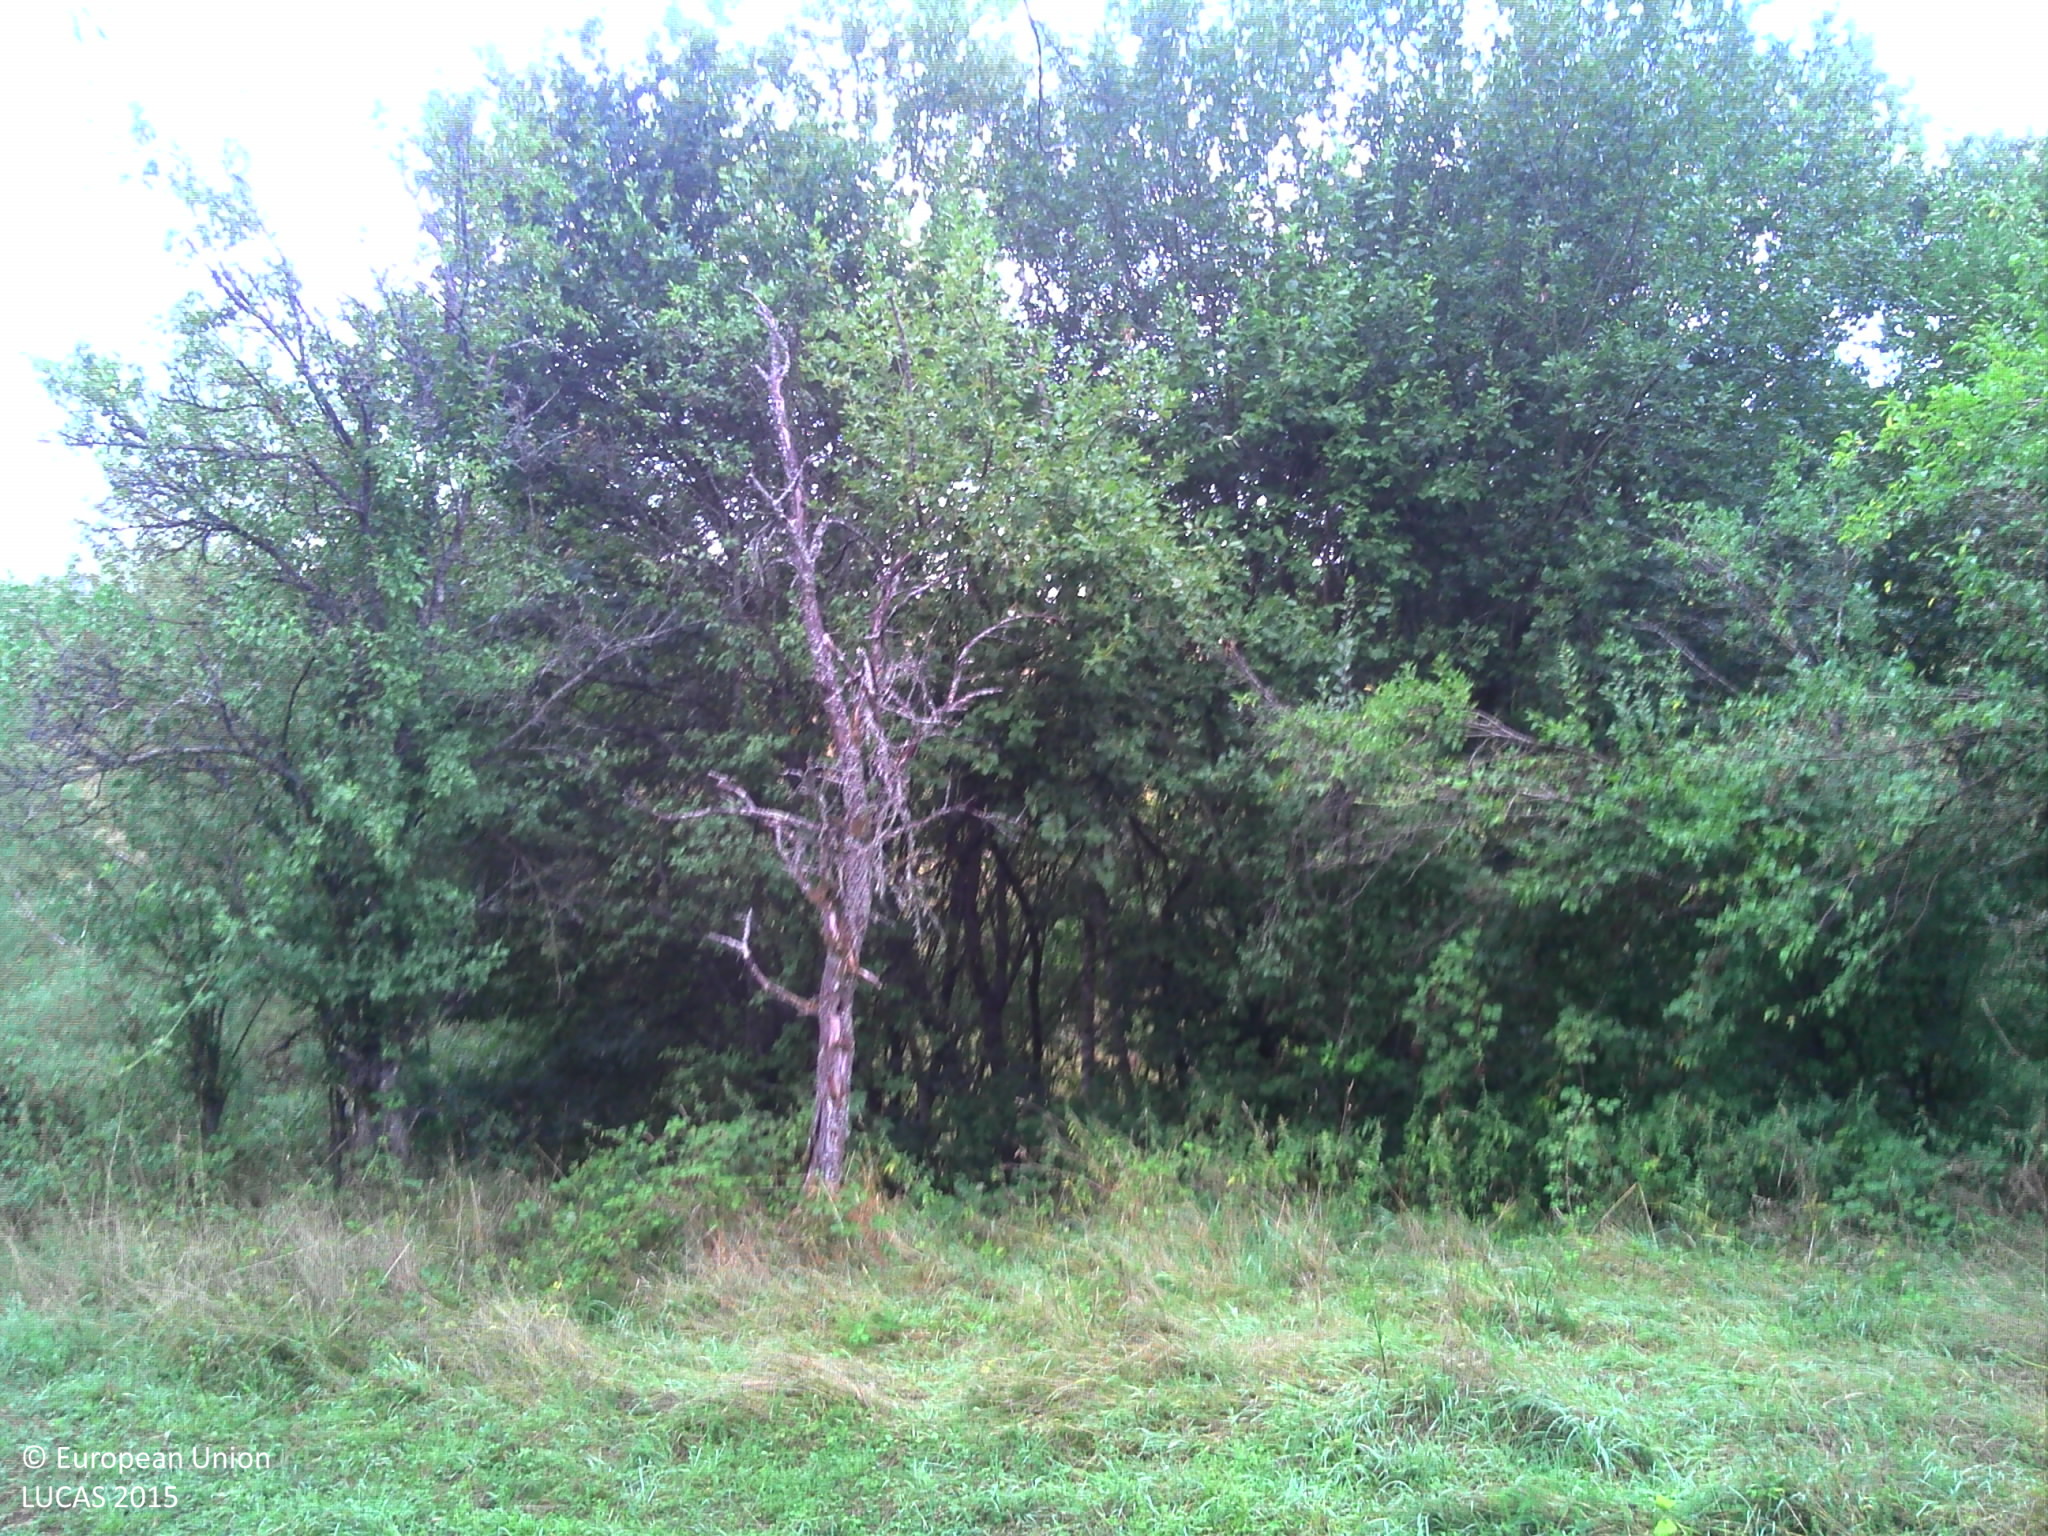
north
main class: Grassland
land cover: Grassland with sparse tree/shrub cover
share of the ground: > 75 %
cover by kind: herbaceous plants 95 %, broadleaved forest trees 5 %
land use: Agriculture (excluding fallow land and kitchen gardens)
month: August
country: FR
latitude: 48.9109
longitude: 7.3126
